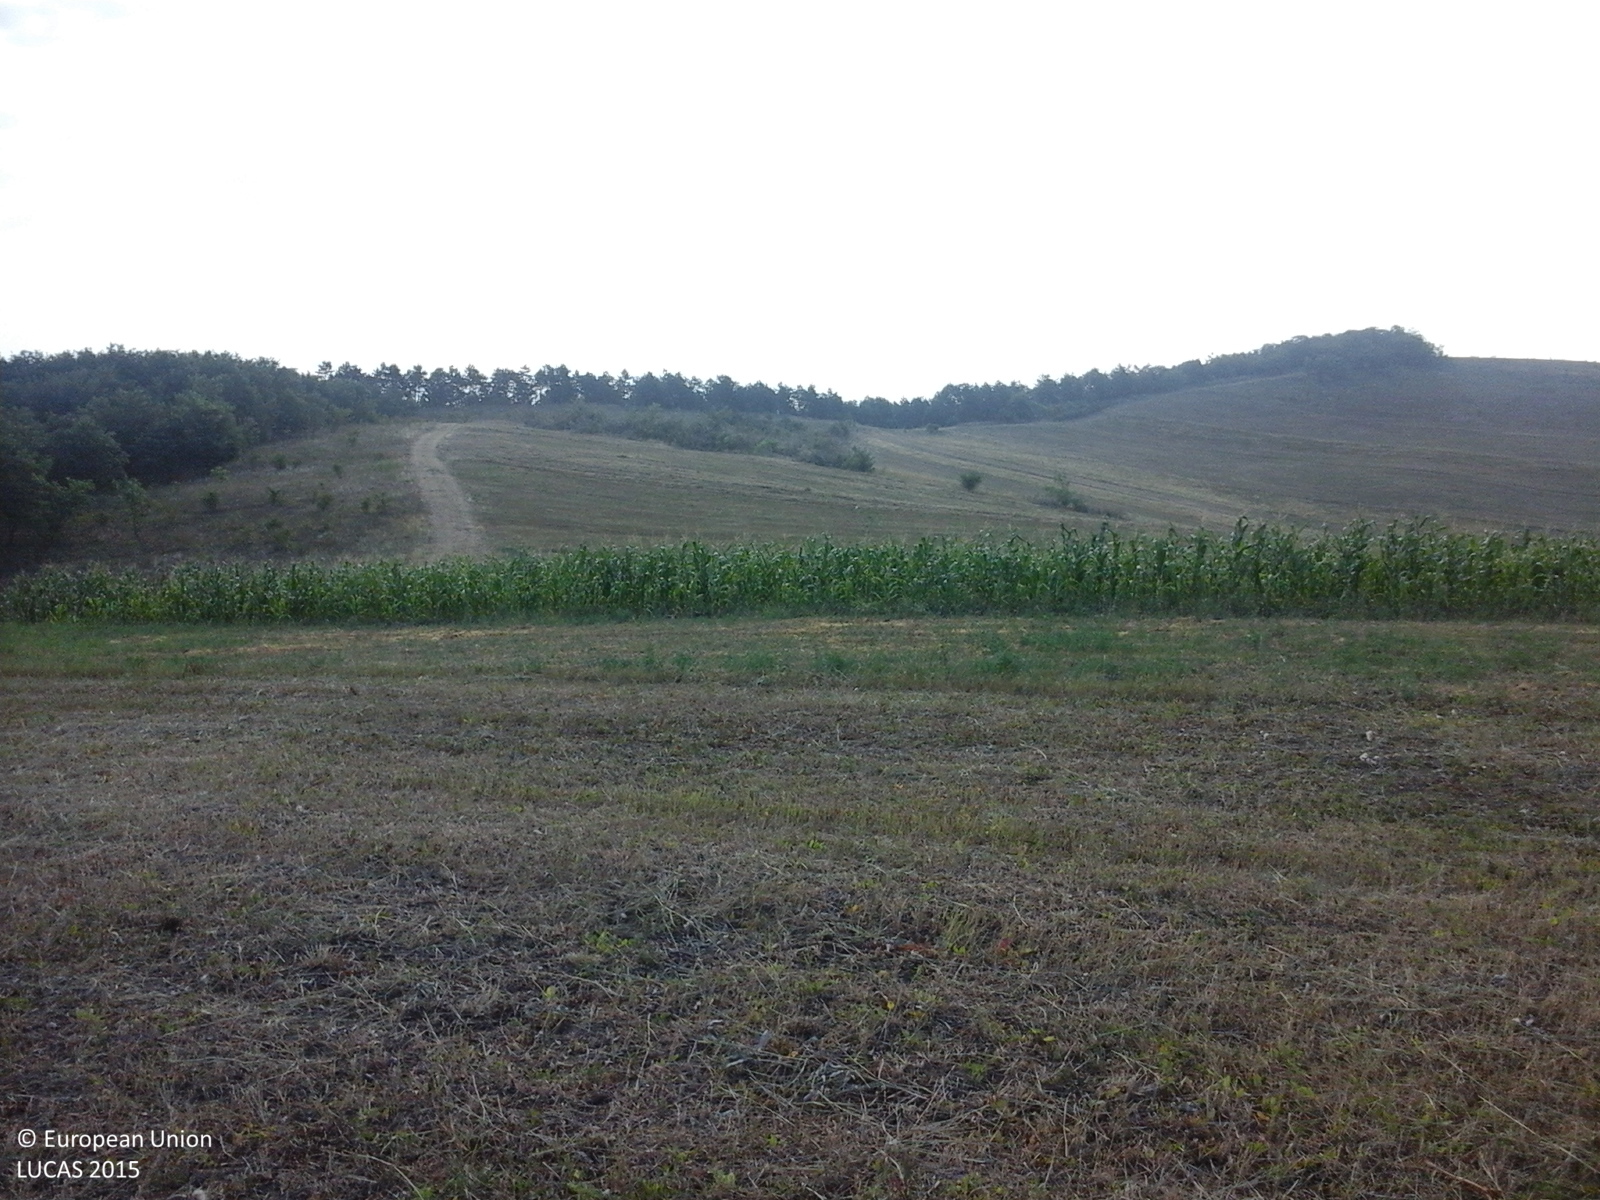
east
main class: Grassland
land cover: Grassland without tree/shrub cover
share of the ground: > 75 %
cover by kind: herbaceous plants 100 %
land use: Agriculture (excluding fallow land and kitchen gardens)
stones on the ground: < 10 %
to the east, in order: Grassland without tree/shrub cover; Lucerne; Maize; Lucerne; Grassland without tree/shrub cover; Abandoned hedges; Spontaneously vegetated surfaces; Oats; Lucerne
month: July
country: RO
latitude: 46.7066
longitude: 27.2255
